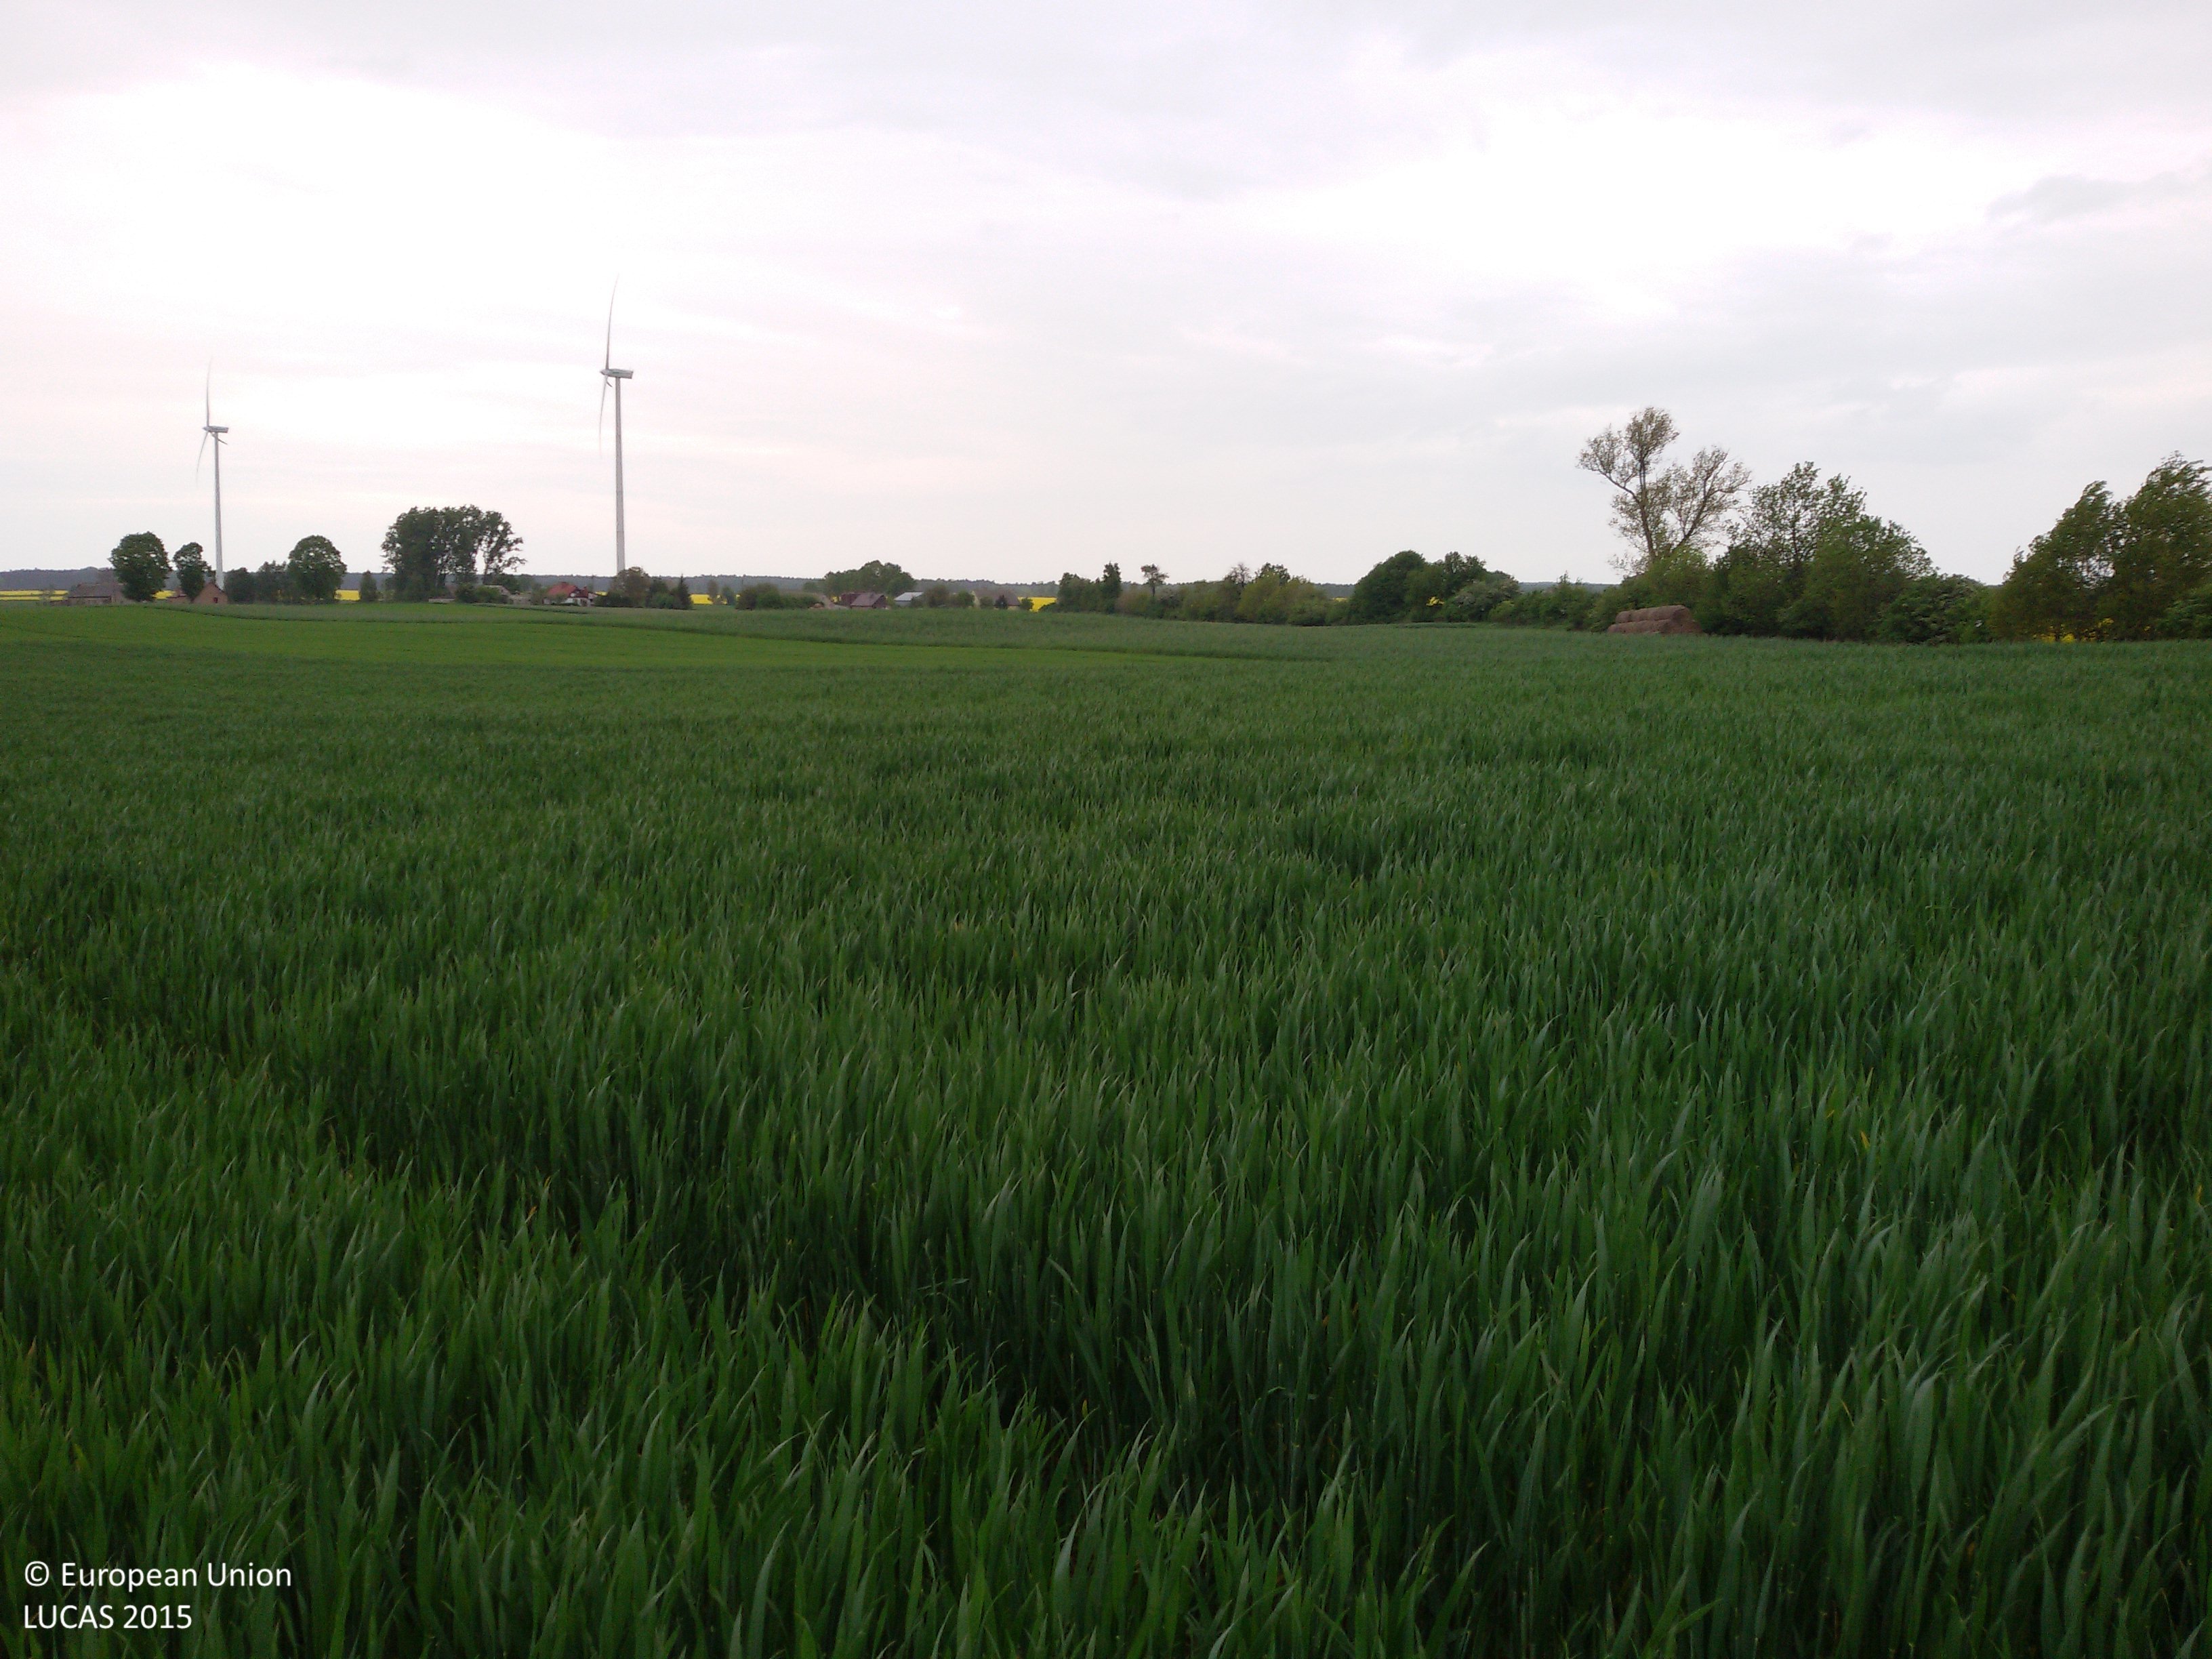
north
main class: Cropland
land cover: Common wheat
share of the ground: > 75 %
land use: Agriculture (excluding fallow land and kitchen gardens)
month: May
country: PL
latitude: 52.9708
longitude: 17.2026
